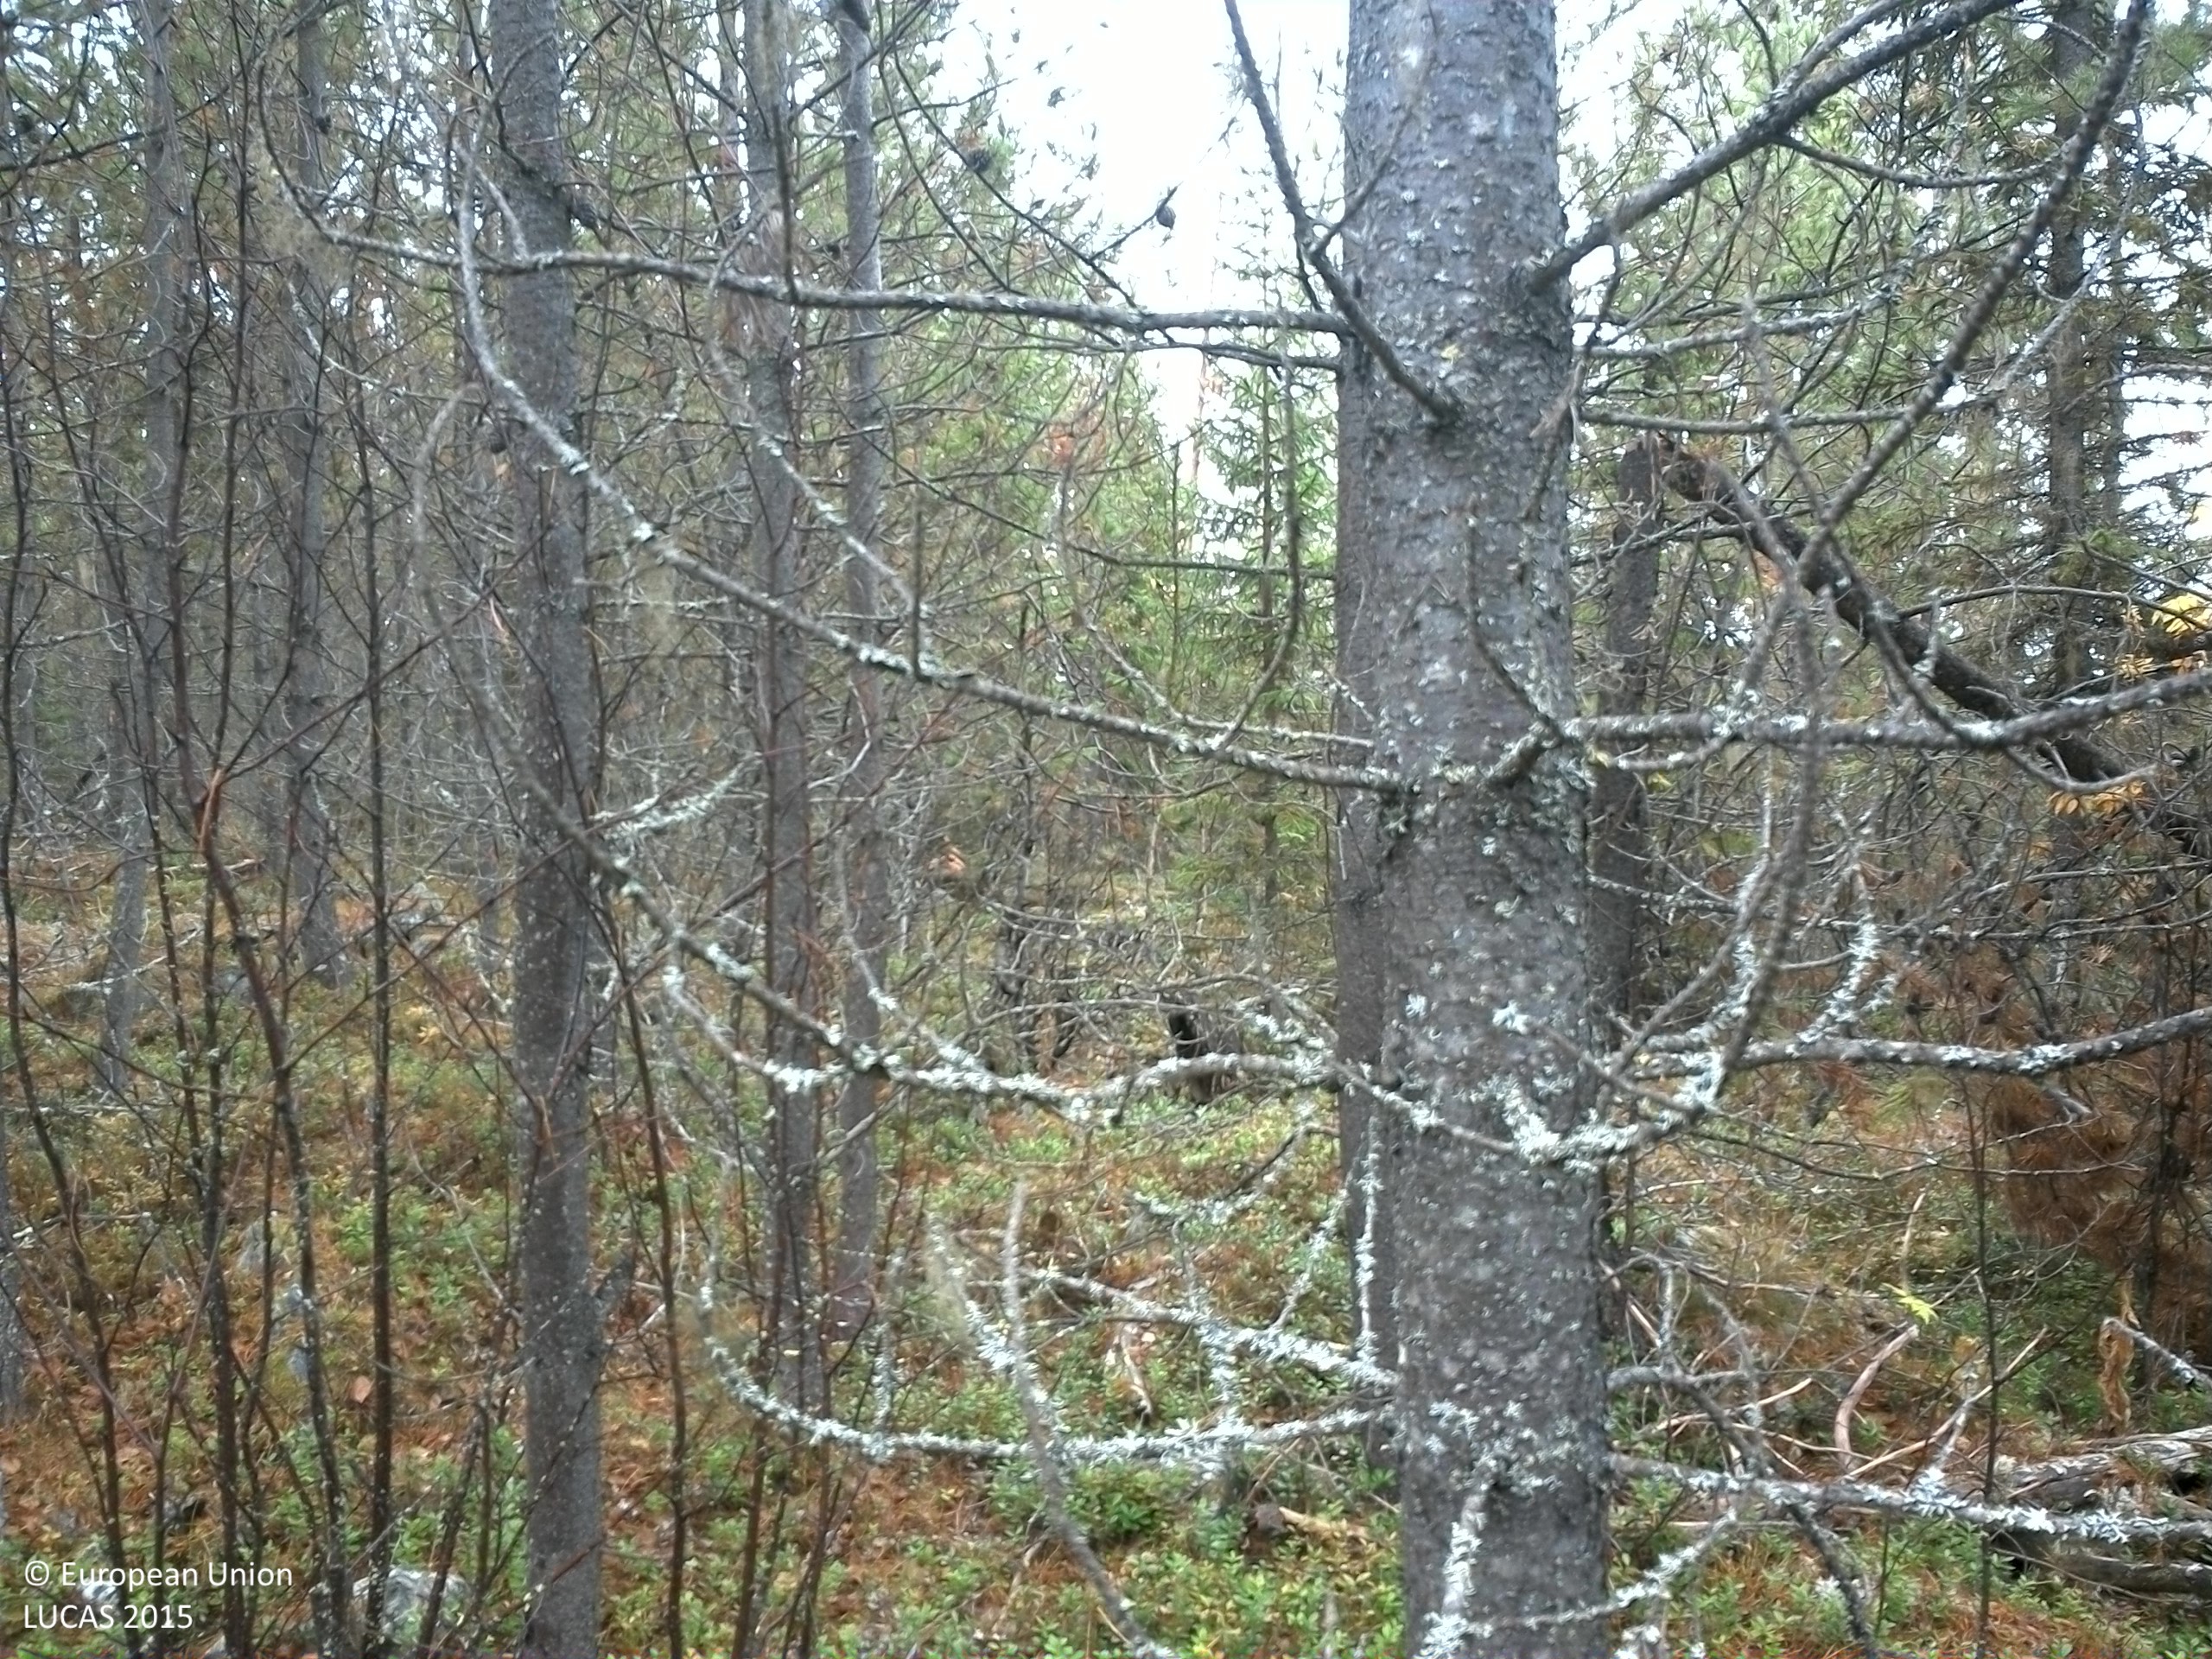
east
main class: Woodland
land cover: Pine dominated coniferous woodland
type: exotic forest
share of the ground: 25 - 50 %
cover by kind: coniferous forest trees 40 %, shrubs 35 %, lichens and mosses 15 %, broadleaved forest trees 5 %, consolidated bare surface 5 %
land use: Forestry
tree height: > 5 m
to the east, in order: Pine dominated coniferous woodland; Spruce dominated coniferous woodland; Peatbogs; Spruce dominated mixed woodland; Pine dominated mixed woodland; Rocks and stones
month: October
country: SE
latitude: 64.3405
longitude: 15.4560
